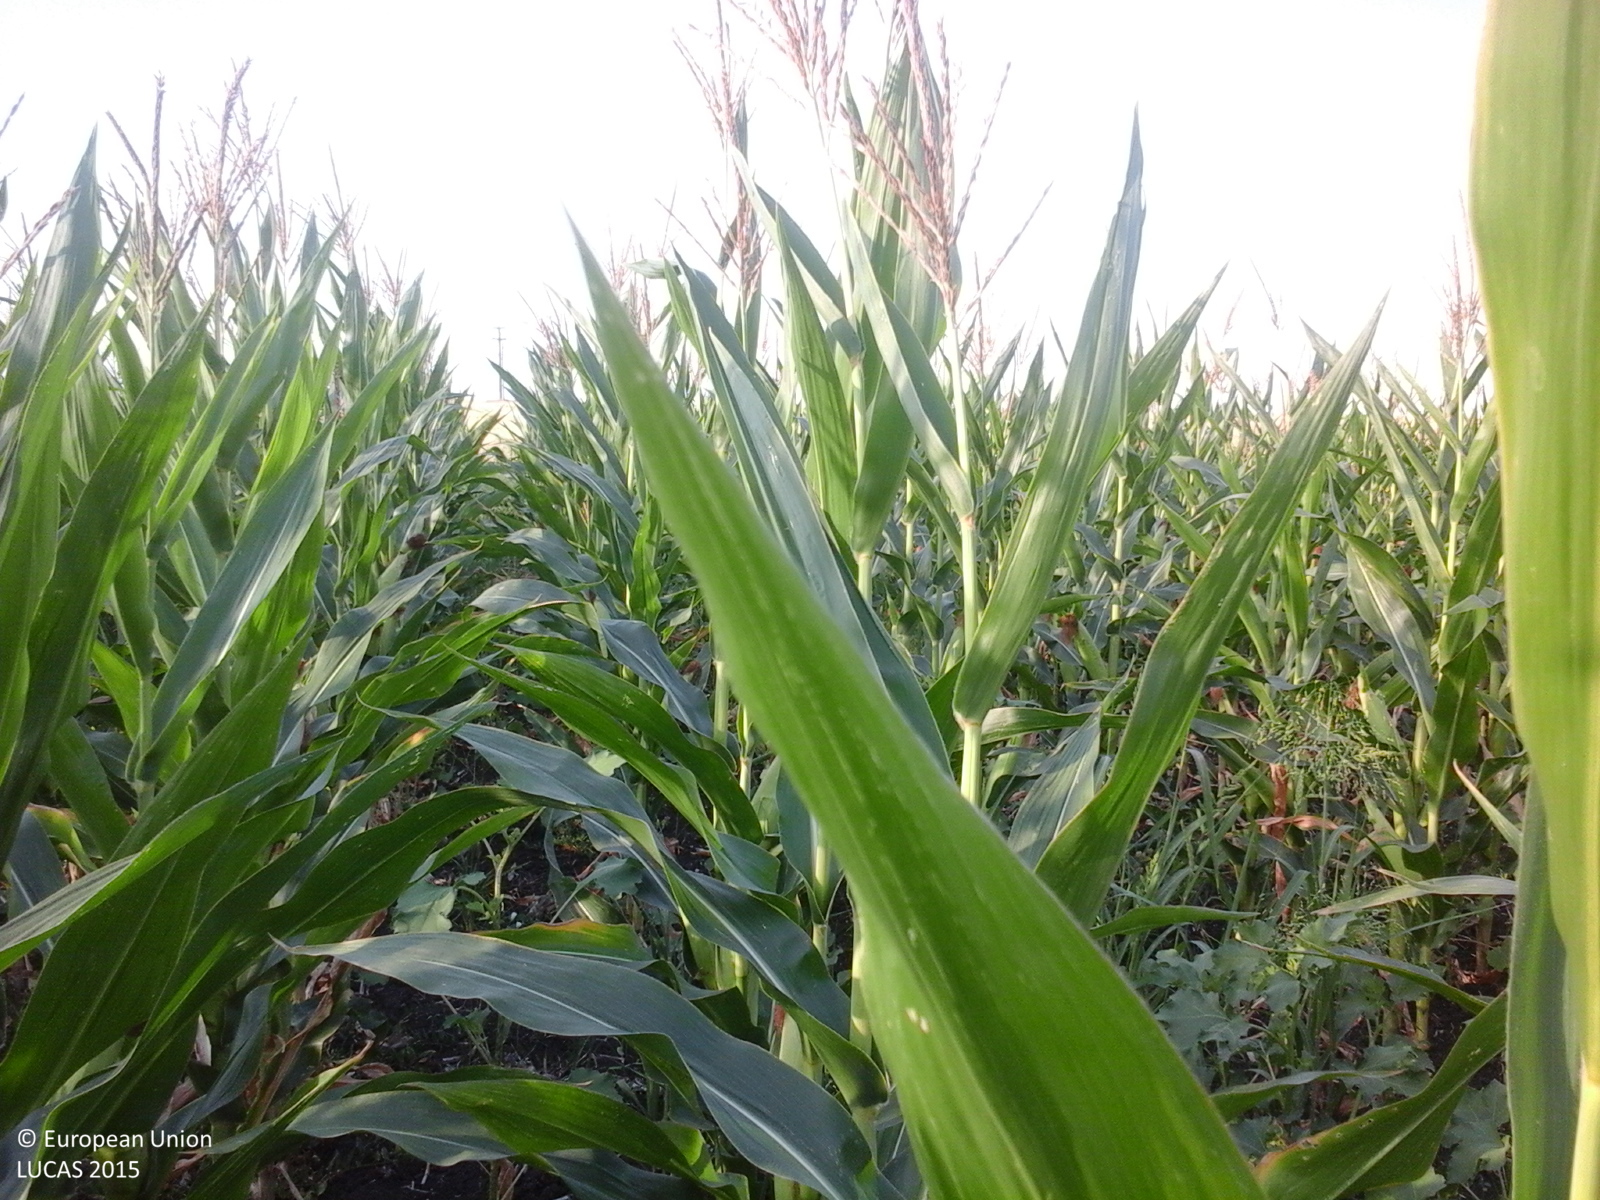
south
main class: Cropland
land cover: Maize
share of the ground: > 75 %
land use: Agriculture (excluding fallow land and kitchen gardens)
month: July
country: RO
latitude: 46.2181
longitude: 28.0543
